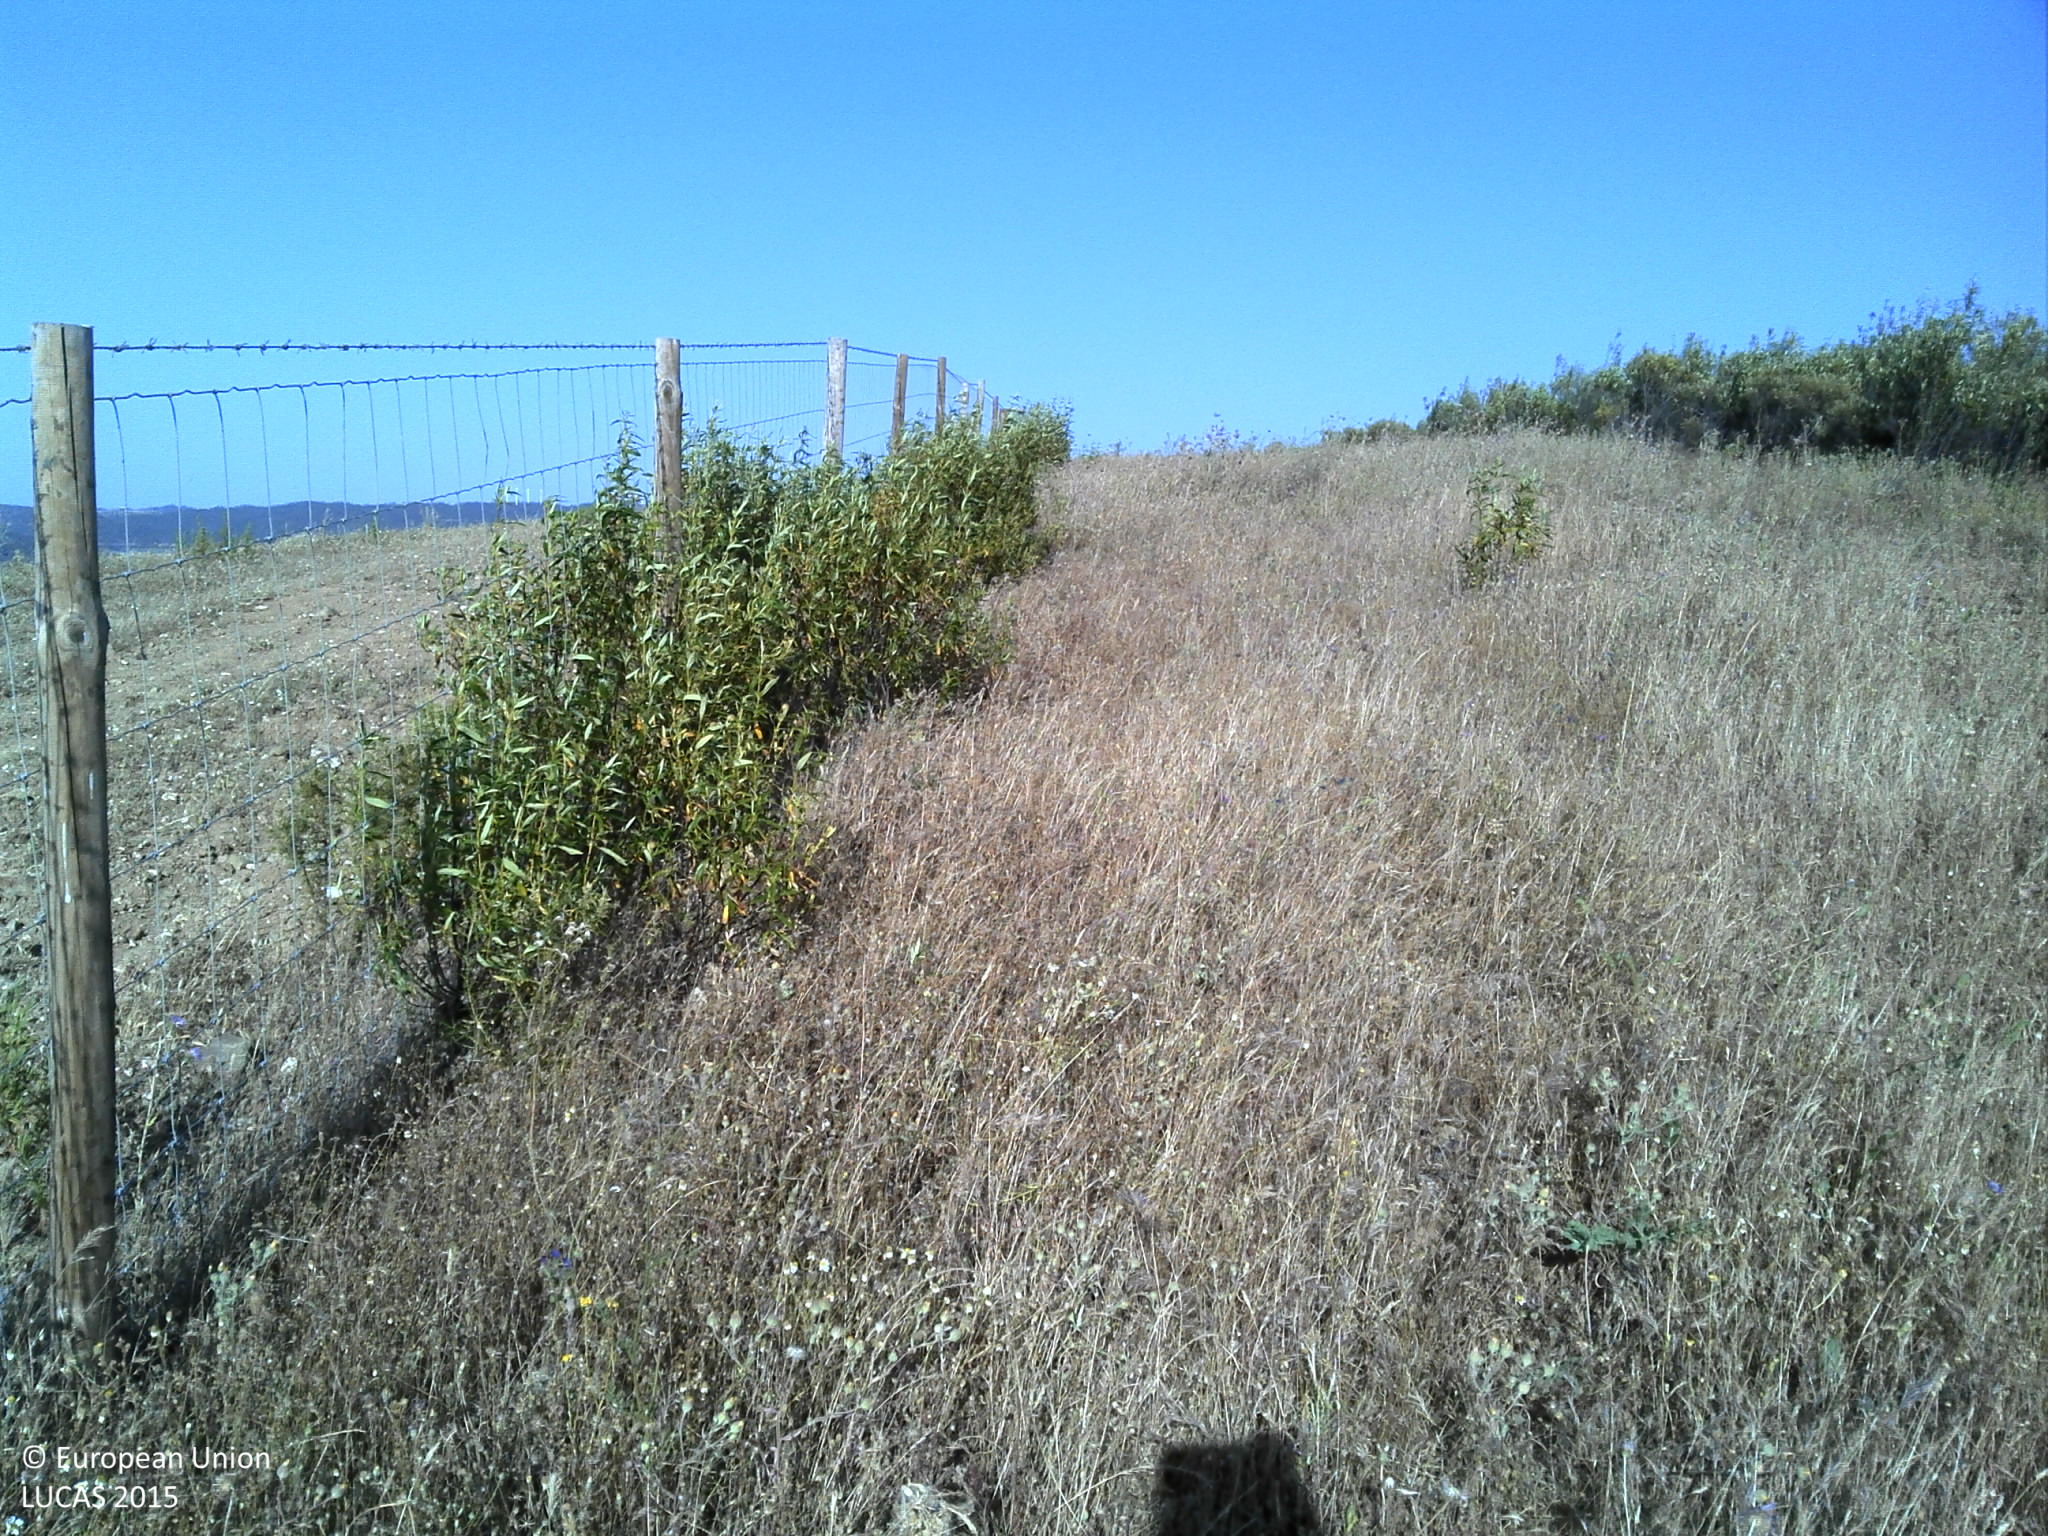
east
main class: Grassland
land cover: Grassland without tree/shrub cover
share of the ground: > 75 %
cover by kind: herbaceous plants 85 %, unconsolidated bare surface 15 %
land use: Agriculture (excluding fallow land and kitchen gardens)
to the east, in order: Grassland without tree/shrub cover; Other structural elements; Grass margins; Tracks; Fences; Grassland without tree/shrub cover; Tracks; Shrubland without tree cover
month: May
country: PT
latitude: 37.5414
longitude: -7.5653
